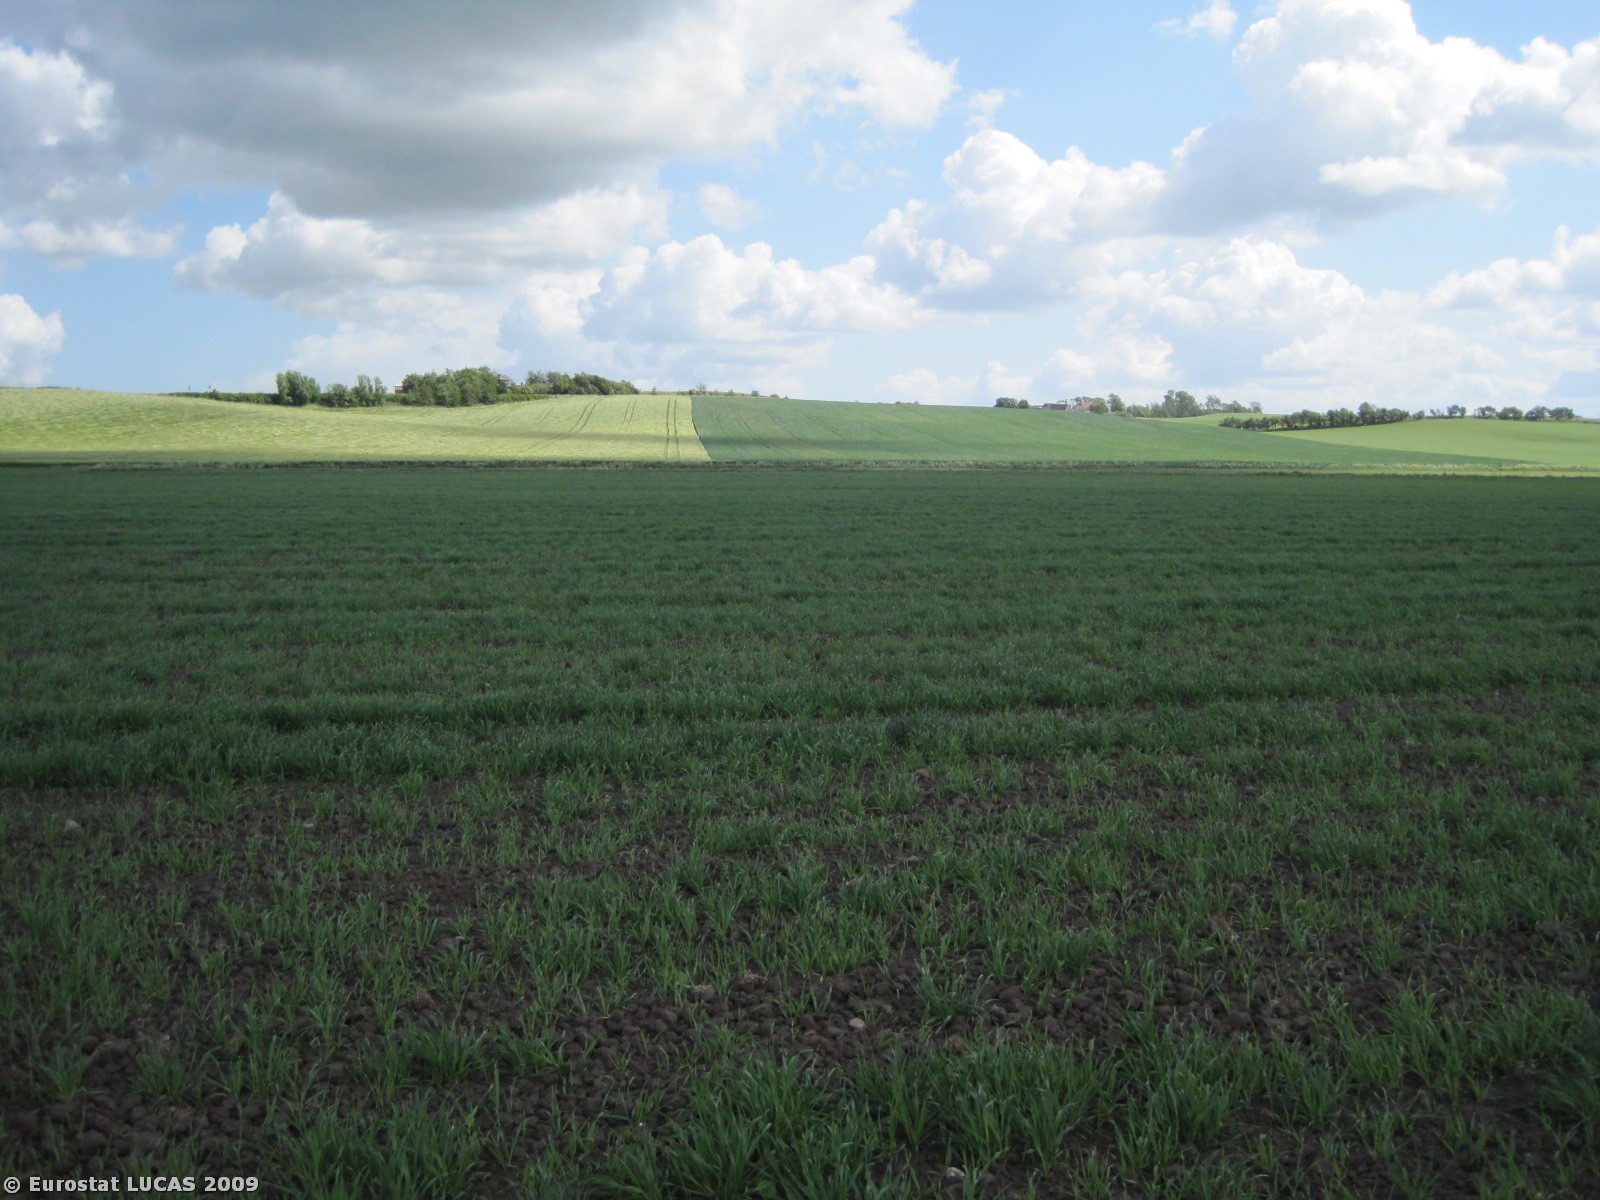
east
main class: Cropland
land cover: Barley
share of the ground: 50 - 75 %
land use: Agriculture (excluding fallow land and kitchen gardens)
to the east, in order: Barley; Grass margins; Ditches and canals; Grass margins; Barley; Grass margins; Tracks; Grass margins; Common wheat
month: May
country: DK
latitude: 56.5651
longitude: 9.8212
